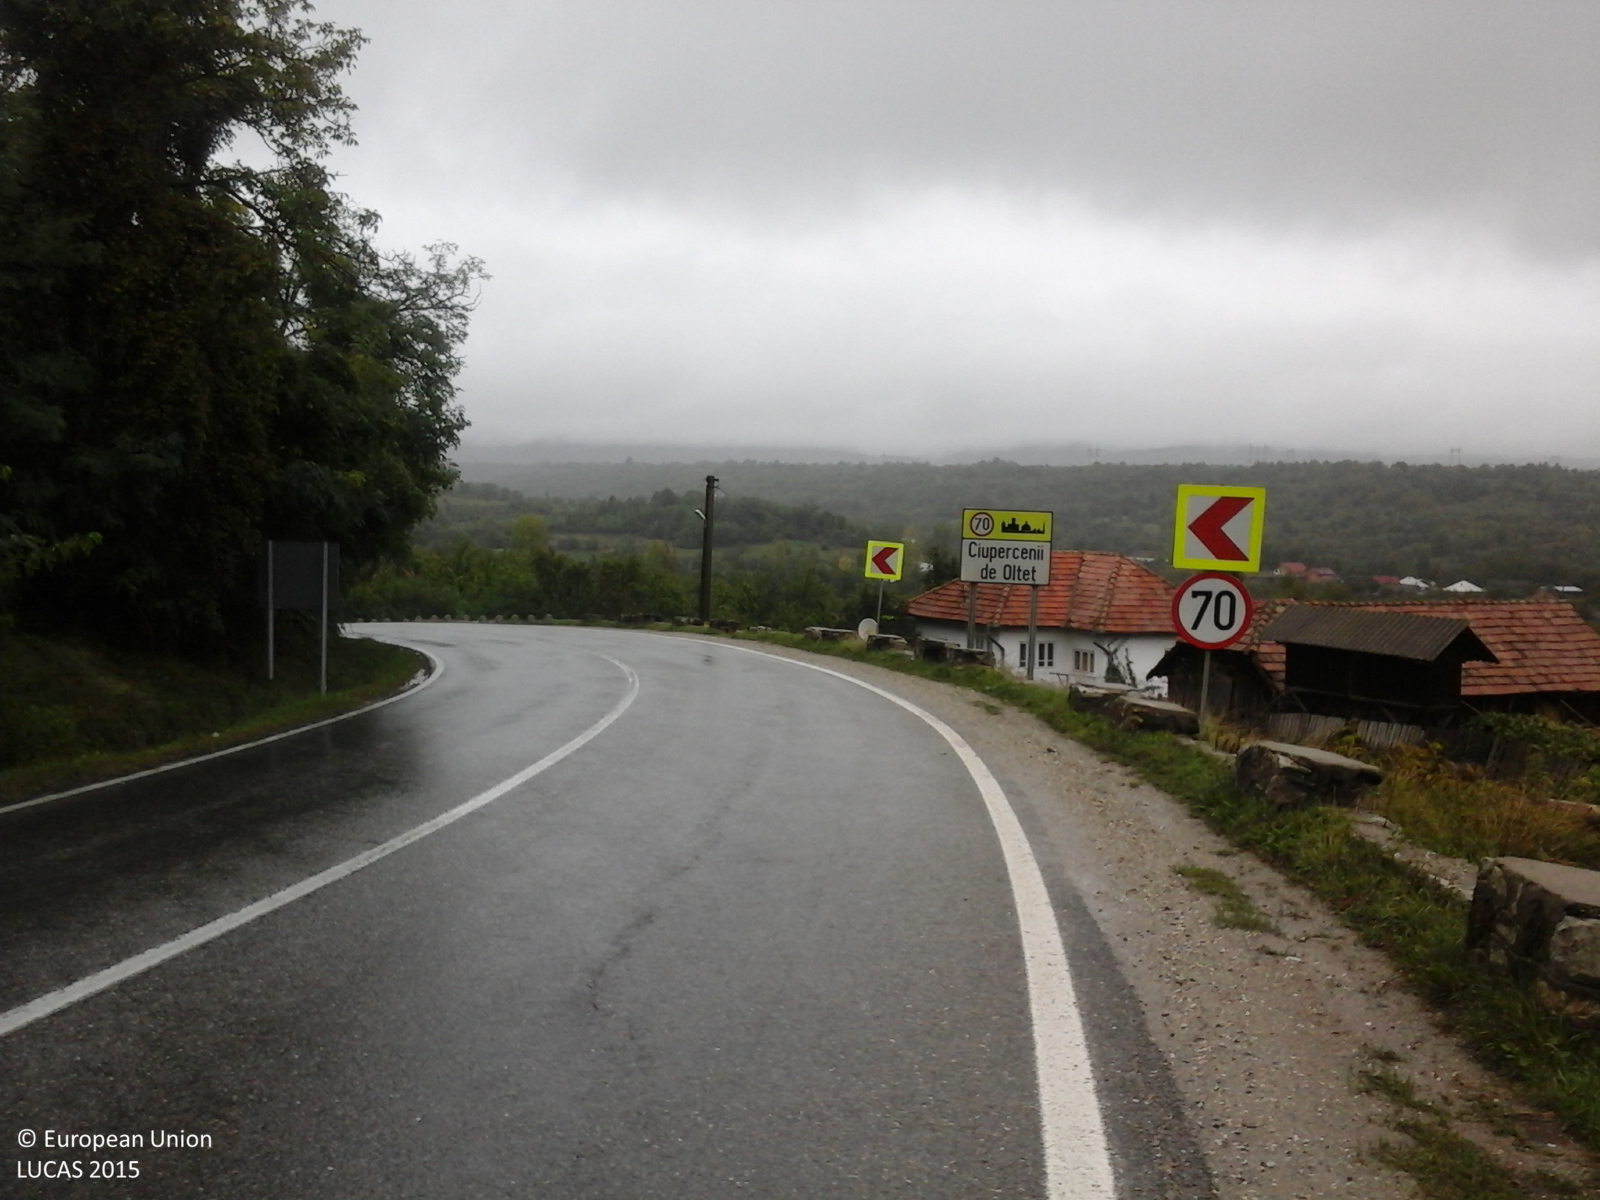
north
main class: Grassland
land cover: Grassland without tree/shrub cover
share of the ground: > 75 %
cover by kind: herbaceous plants 100 %
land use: Agriculture (excluding fallow land and kitchen gardens)
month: September
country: RO
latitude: 45.1430
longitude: 23.7855
